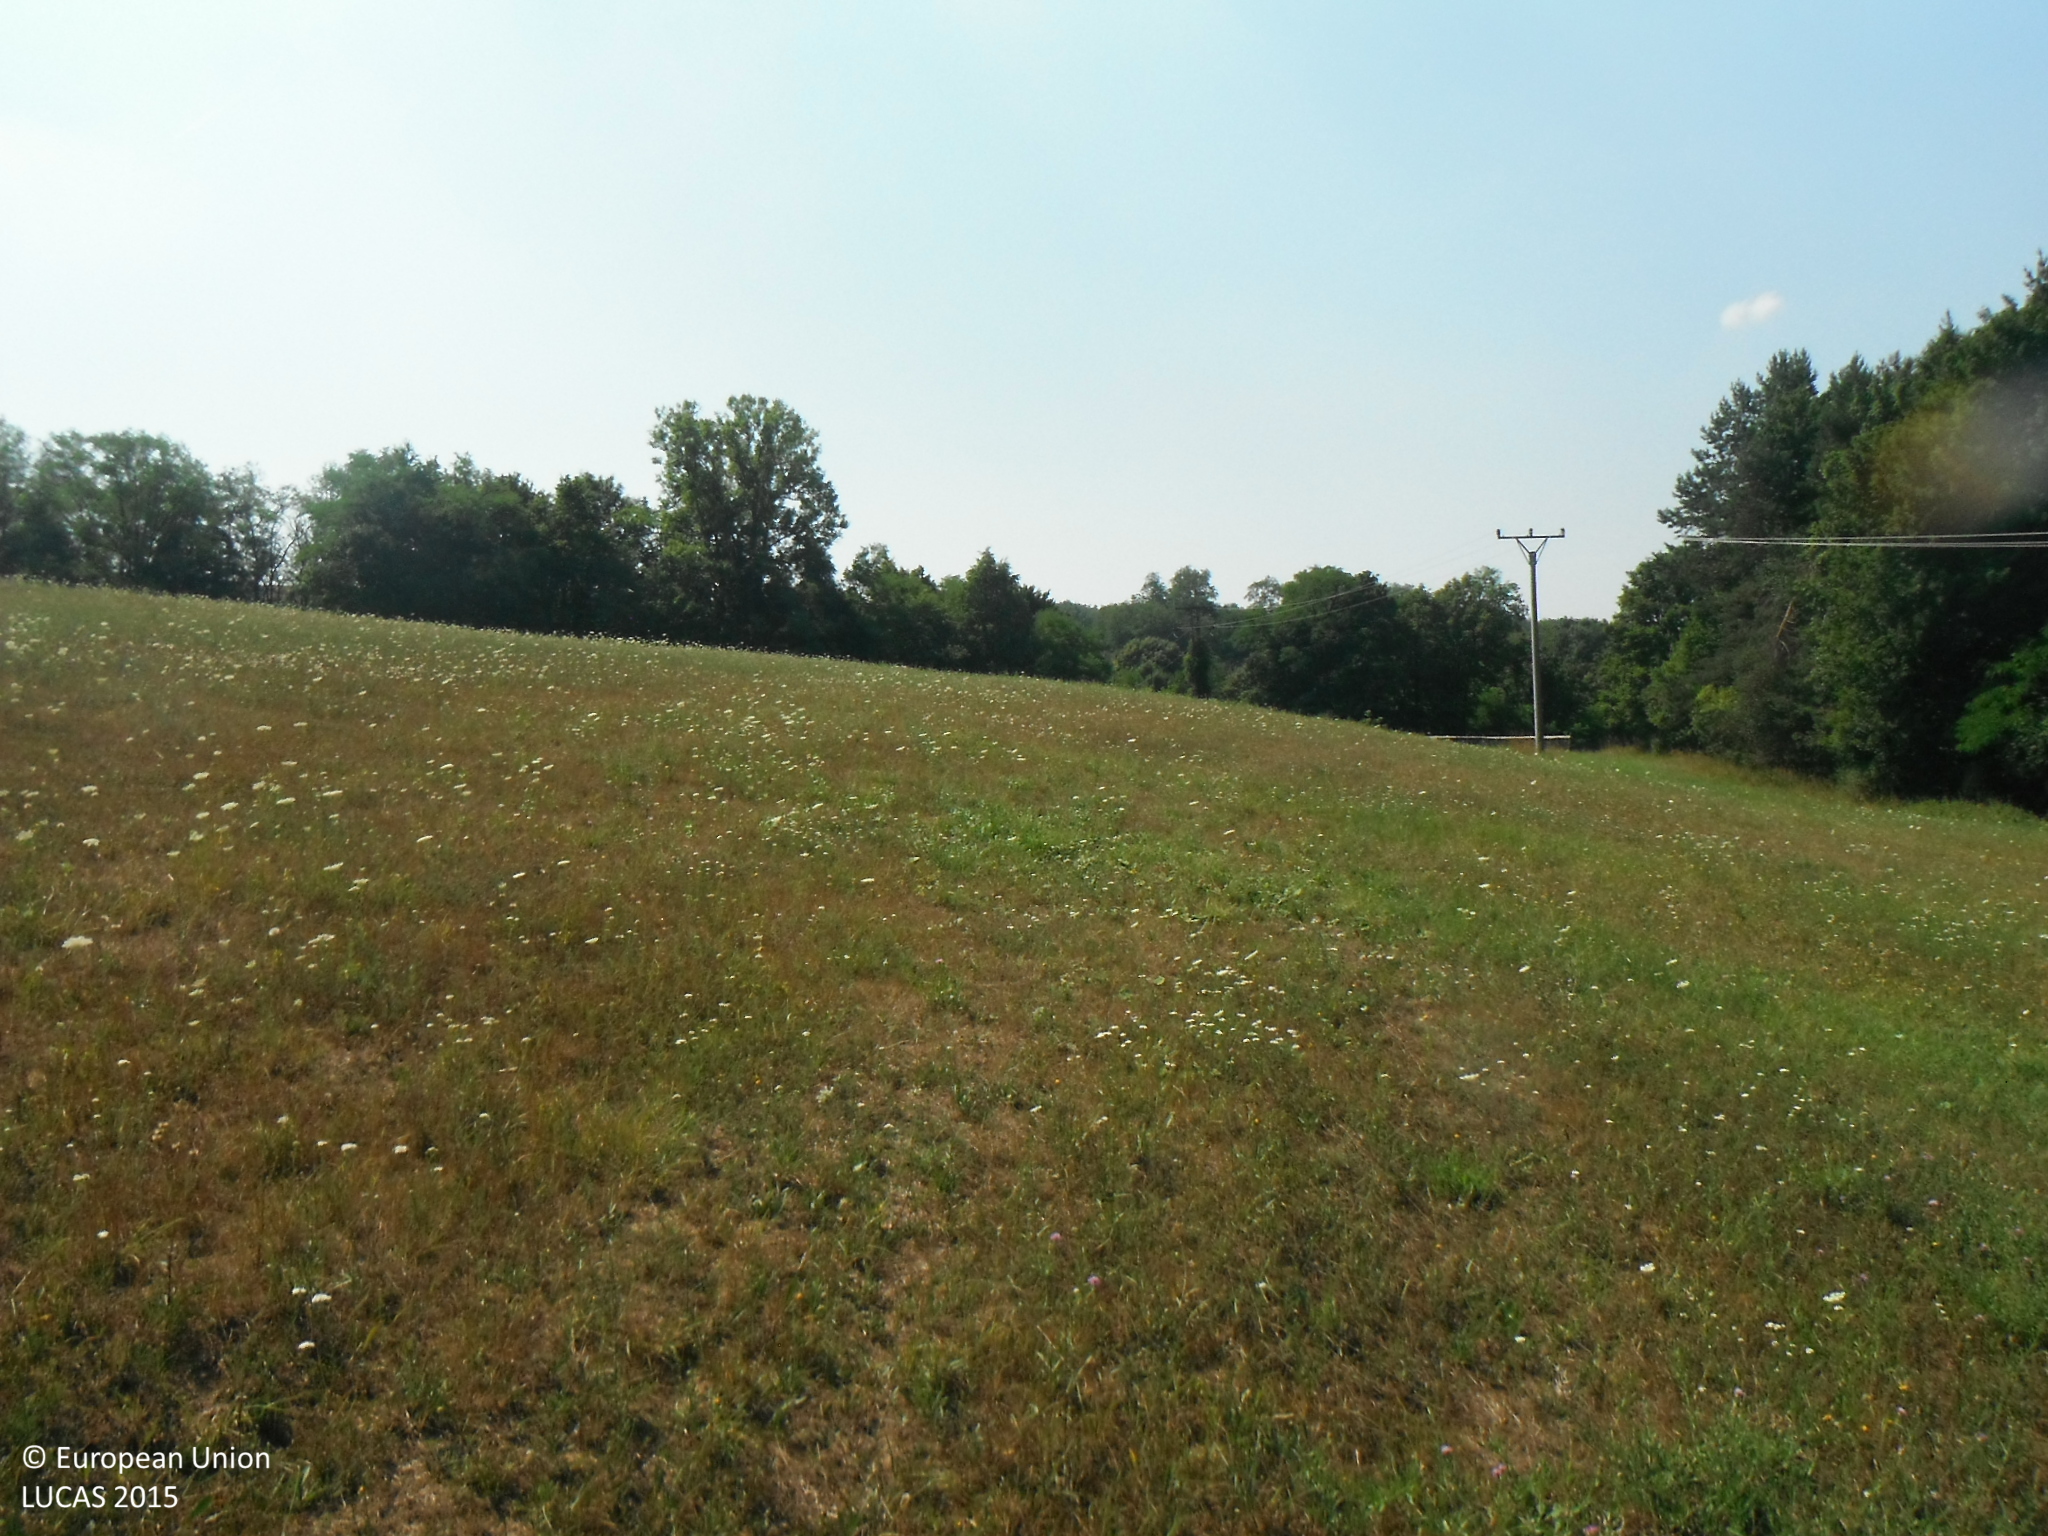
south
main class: Grassland
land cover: Grassland without tree/shrub cover
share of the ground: > 75 %
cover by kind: herbaceous plants 100 %
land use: Agriculture (excluding fallow land and kitchen gardens)
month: July
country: SK
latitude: 48.6748
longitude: 17.4665
